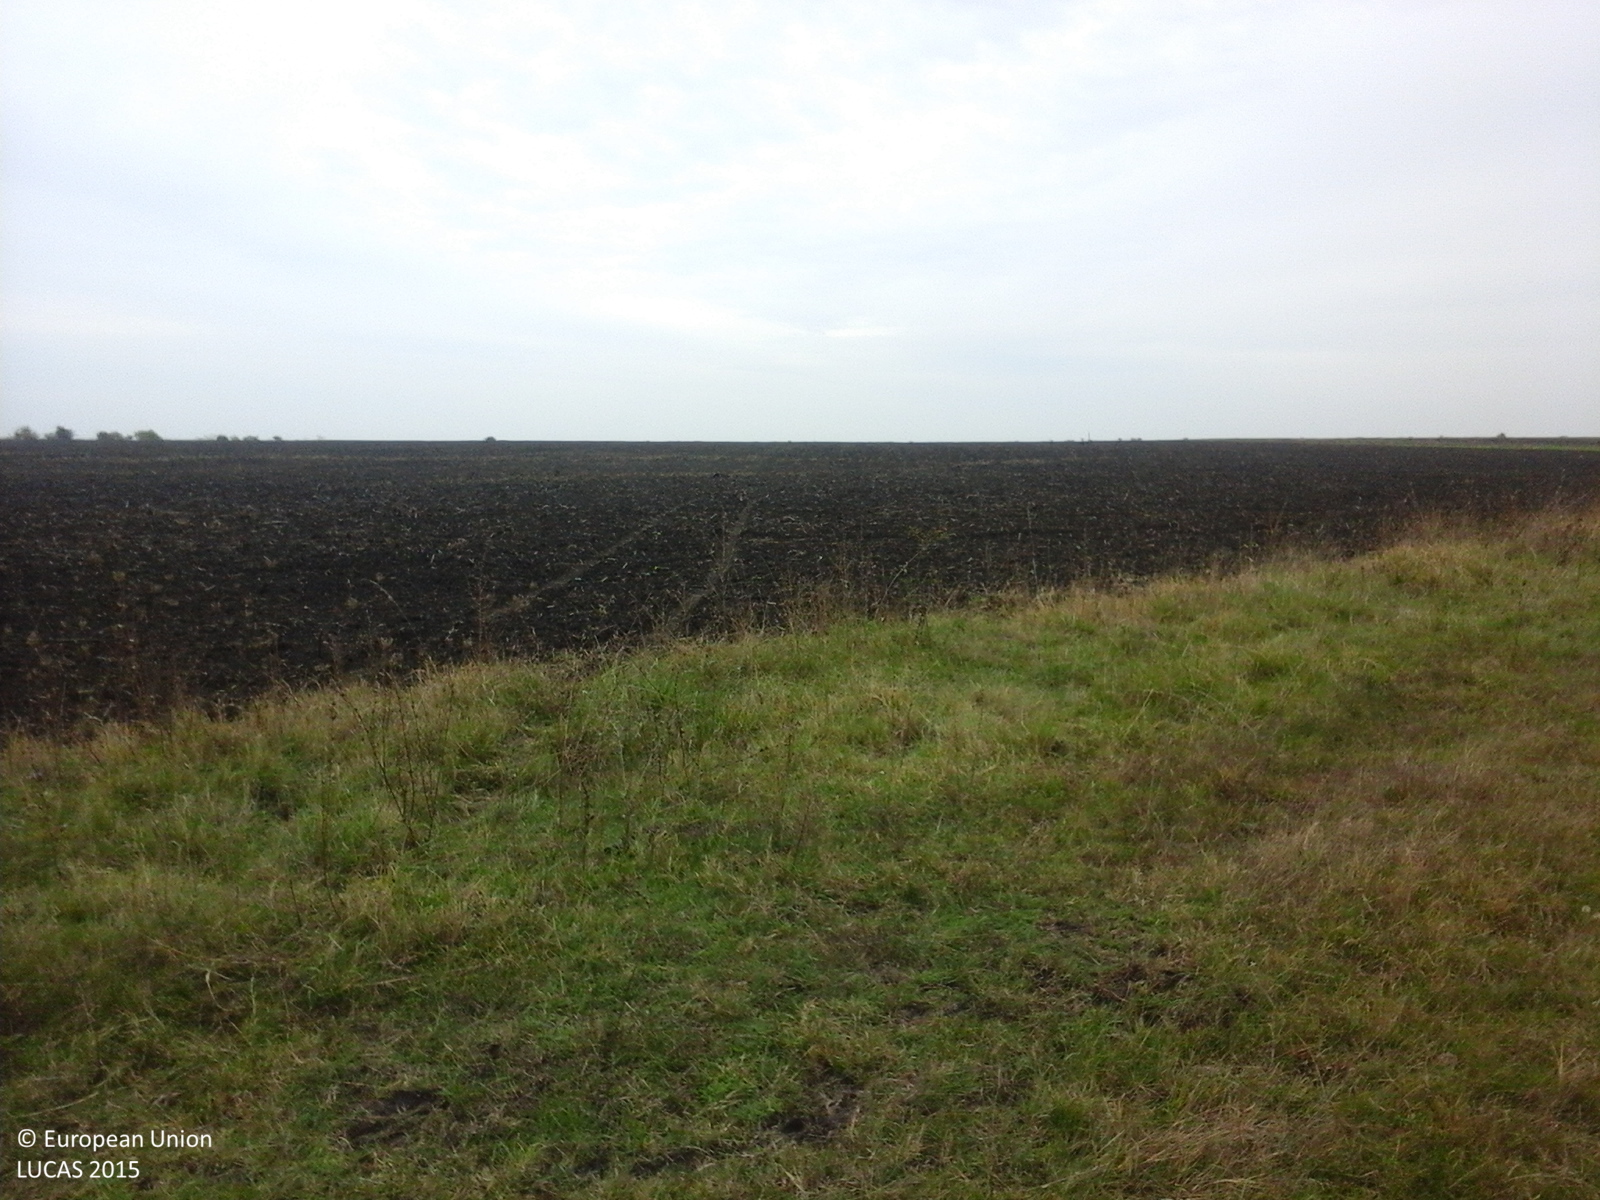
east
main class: Grassland
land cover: Grassland without tree/shrub cover
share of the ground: > 75 %
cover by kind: herbaceous plants 100 %
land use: Agriculture (excluding fallow land and kitchen gardens)
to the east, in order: Grassland without tree/shrub cover; Other bare soil
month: October
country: RO
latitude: 44.9141
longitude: 26.3682
